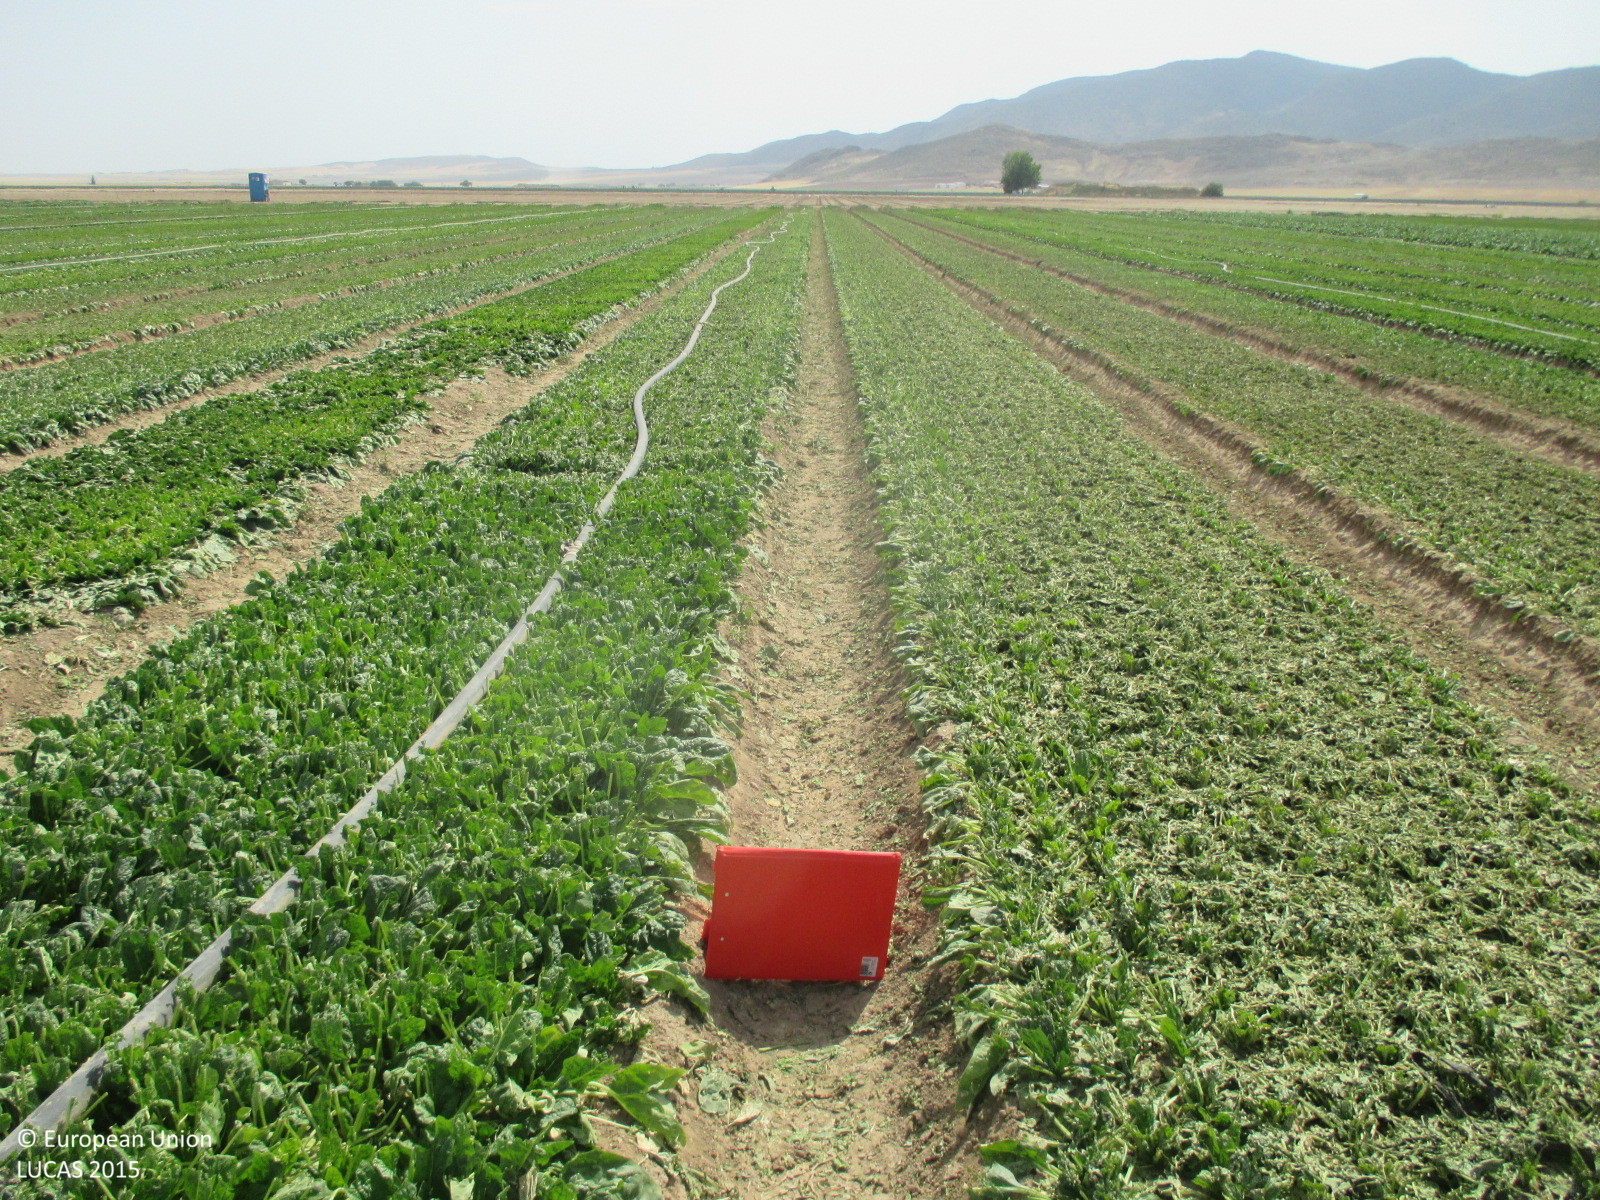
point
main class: Cropland
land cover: Other fresh vegetables
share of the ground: 50 - 75 %
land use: Agriculture (excluding fallow land and kitchen gardens)
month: July
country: ES
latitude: 37.8652
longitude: -2.4141
